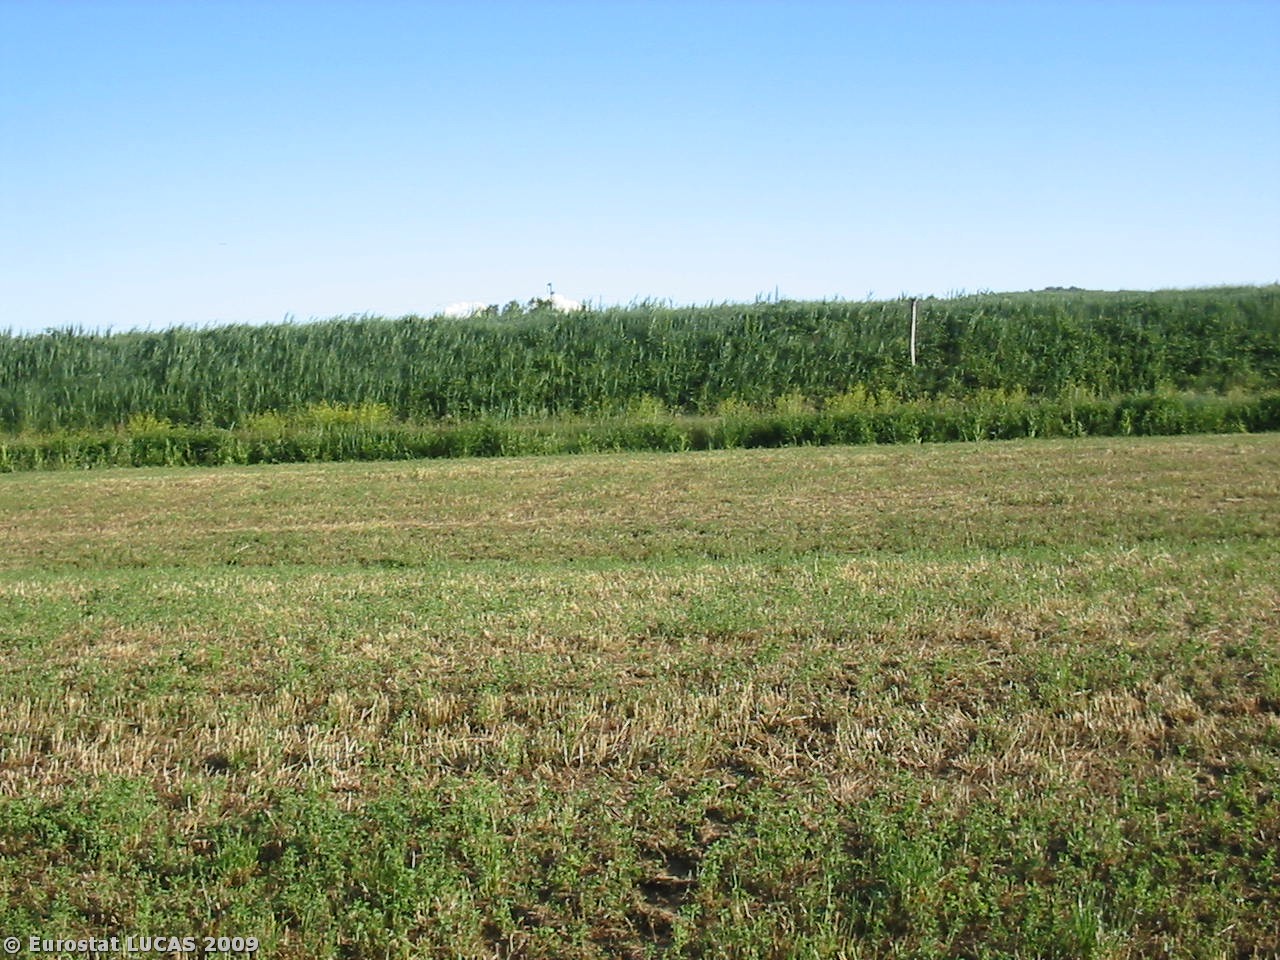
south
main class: Cropland
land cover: Lucerne
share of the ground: > 75 %
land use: Agriculture (excluding fallow land and kitchen gardens)
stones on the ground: < 10 %
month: May
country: IT
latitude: 43.0137
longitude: 11.9939
